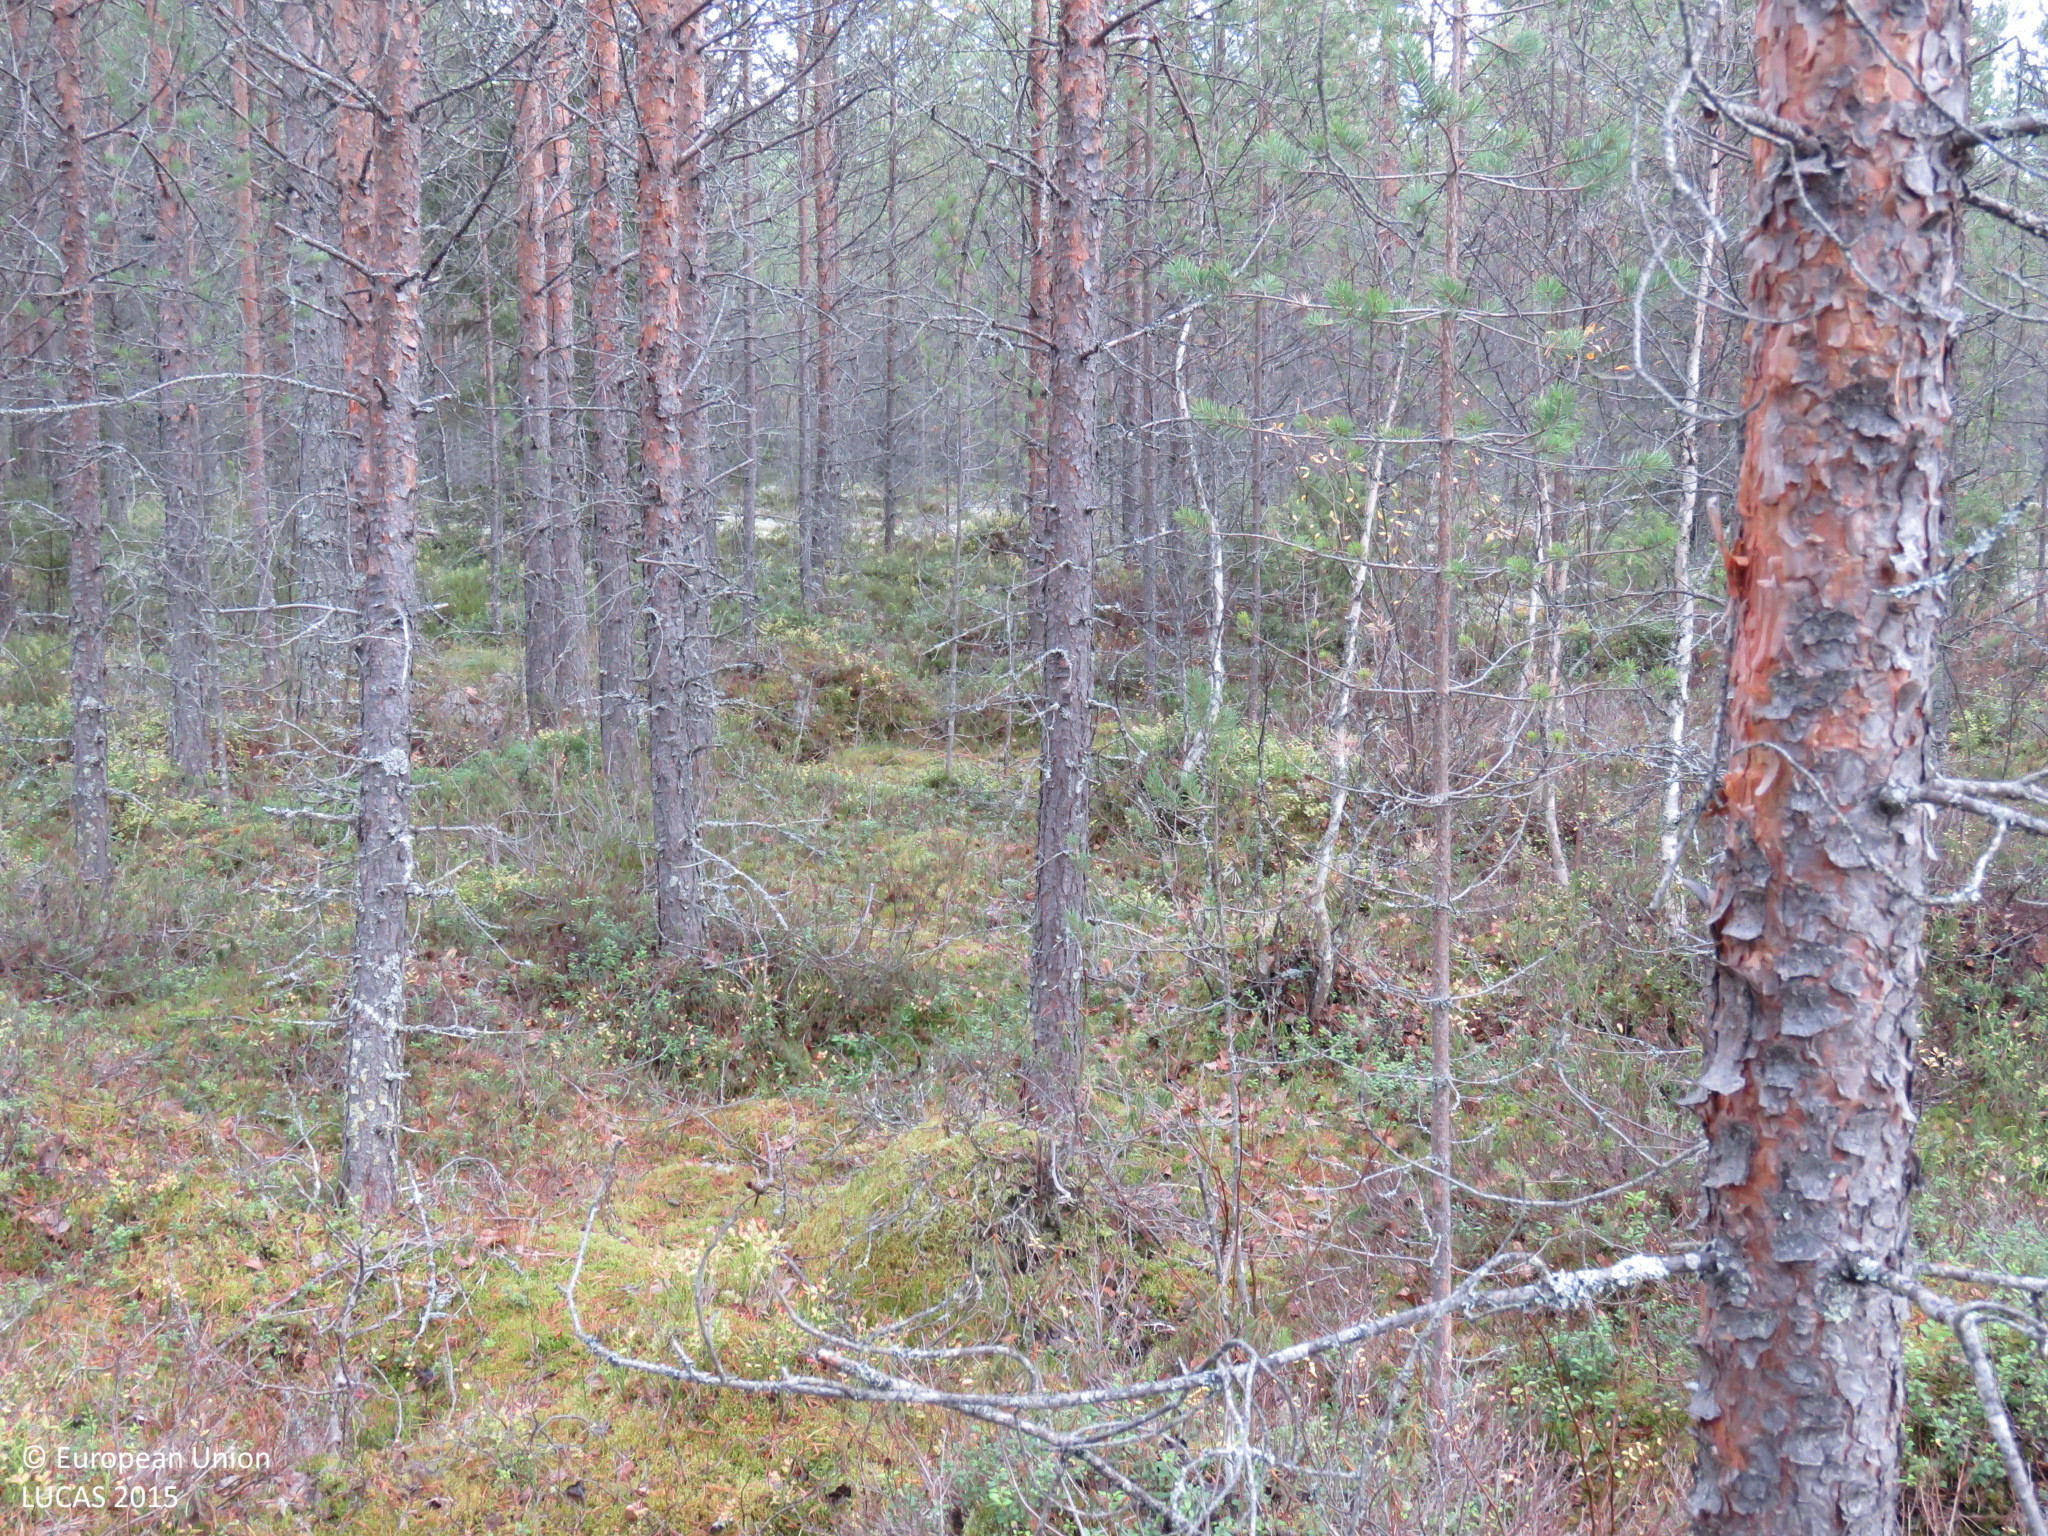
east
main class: Woodland
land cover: Pine dominated coniferous woodland
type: boreal forest
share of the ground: > 75 %
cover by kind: coniferous forest trees 60 %, shrubs 20 %, broadleaved forest trees 15 %, lichens and mosses 5 %
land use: Forestry
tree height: > 5 m
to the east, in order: Pine dominated coniferous woodland; Other coniferous woodland; Pine dominated coniferous woodland; Ditches and canals; Other mixed woodland; Shruby margins; Ditches and canals; Shruby margins; Paved roads, cycling and walking lanes; Shruby margins; Ditches and canals; Shruby margins; Other mixed woodland
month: October
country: FI
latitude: 64.5652
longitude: 27.0101
